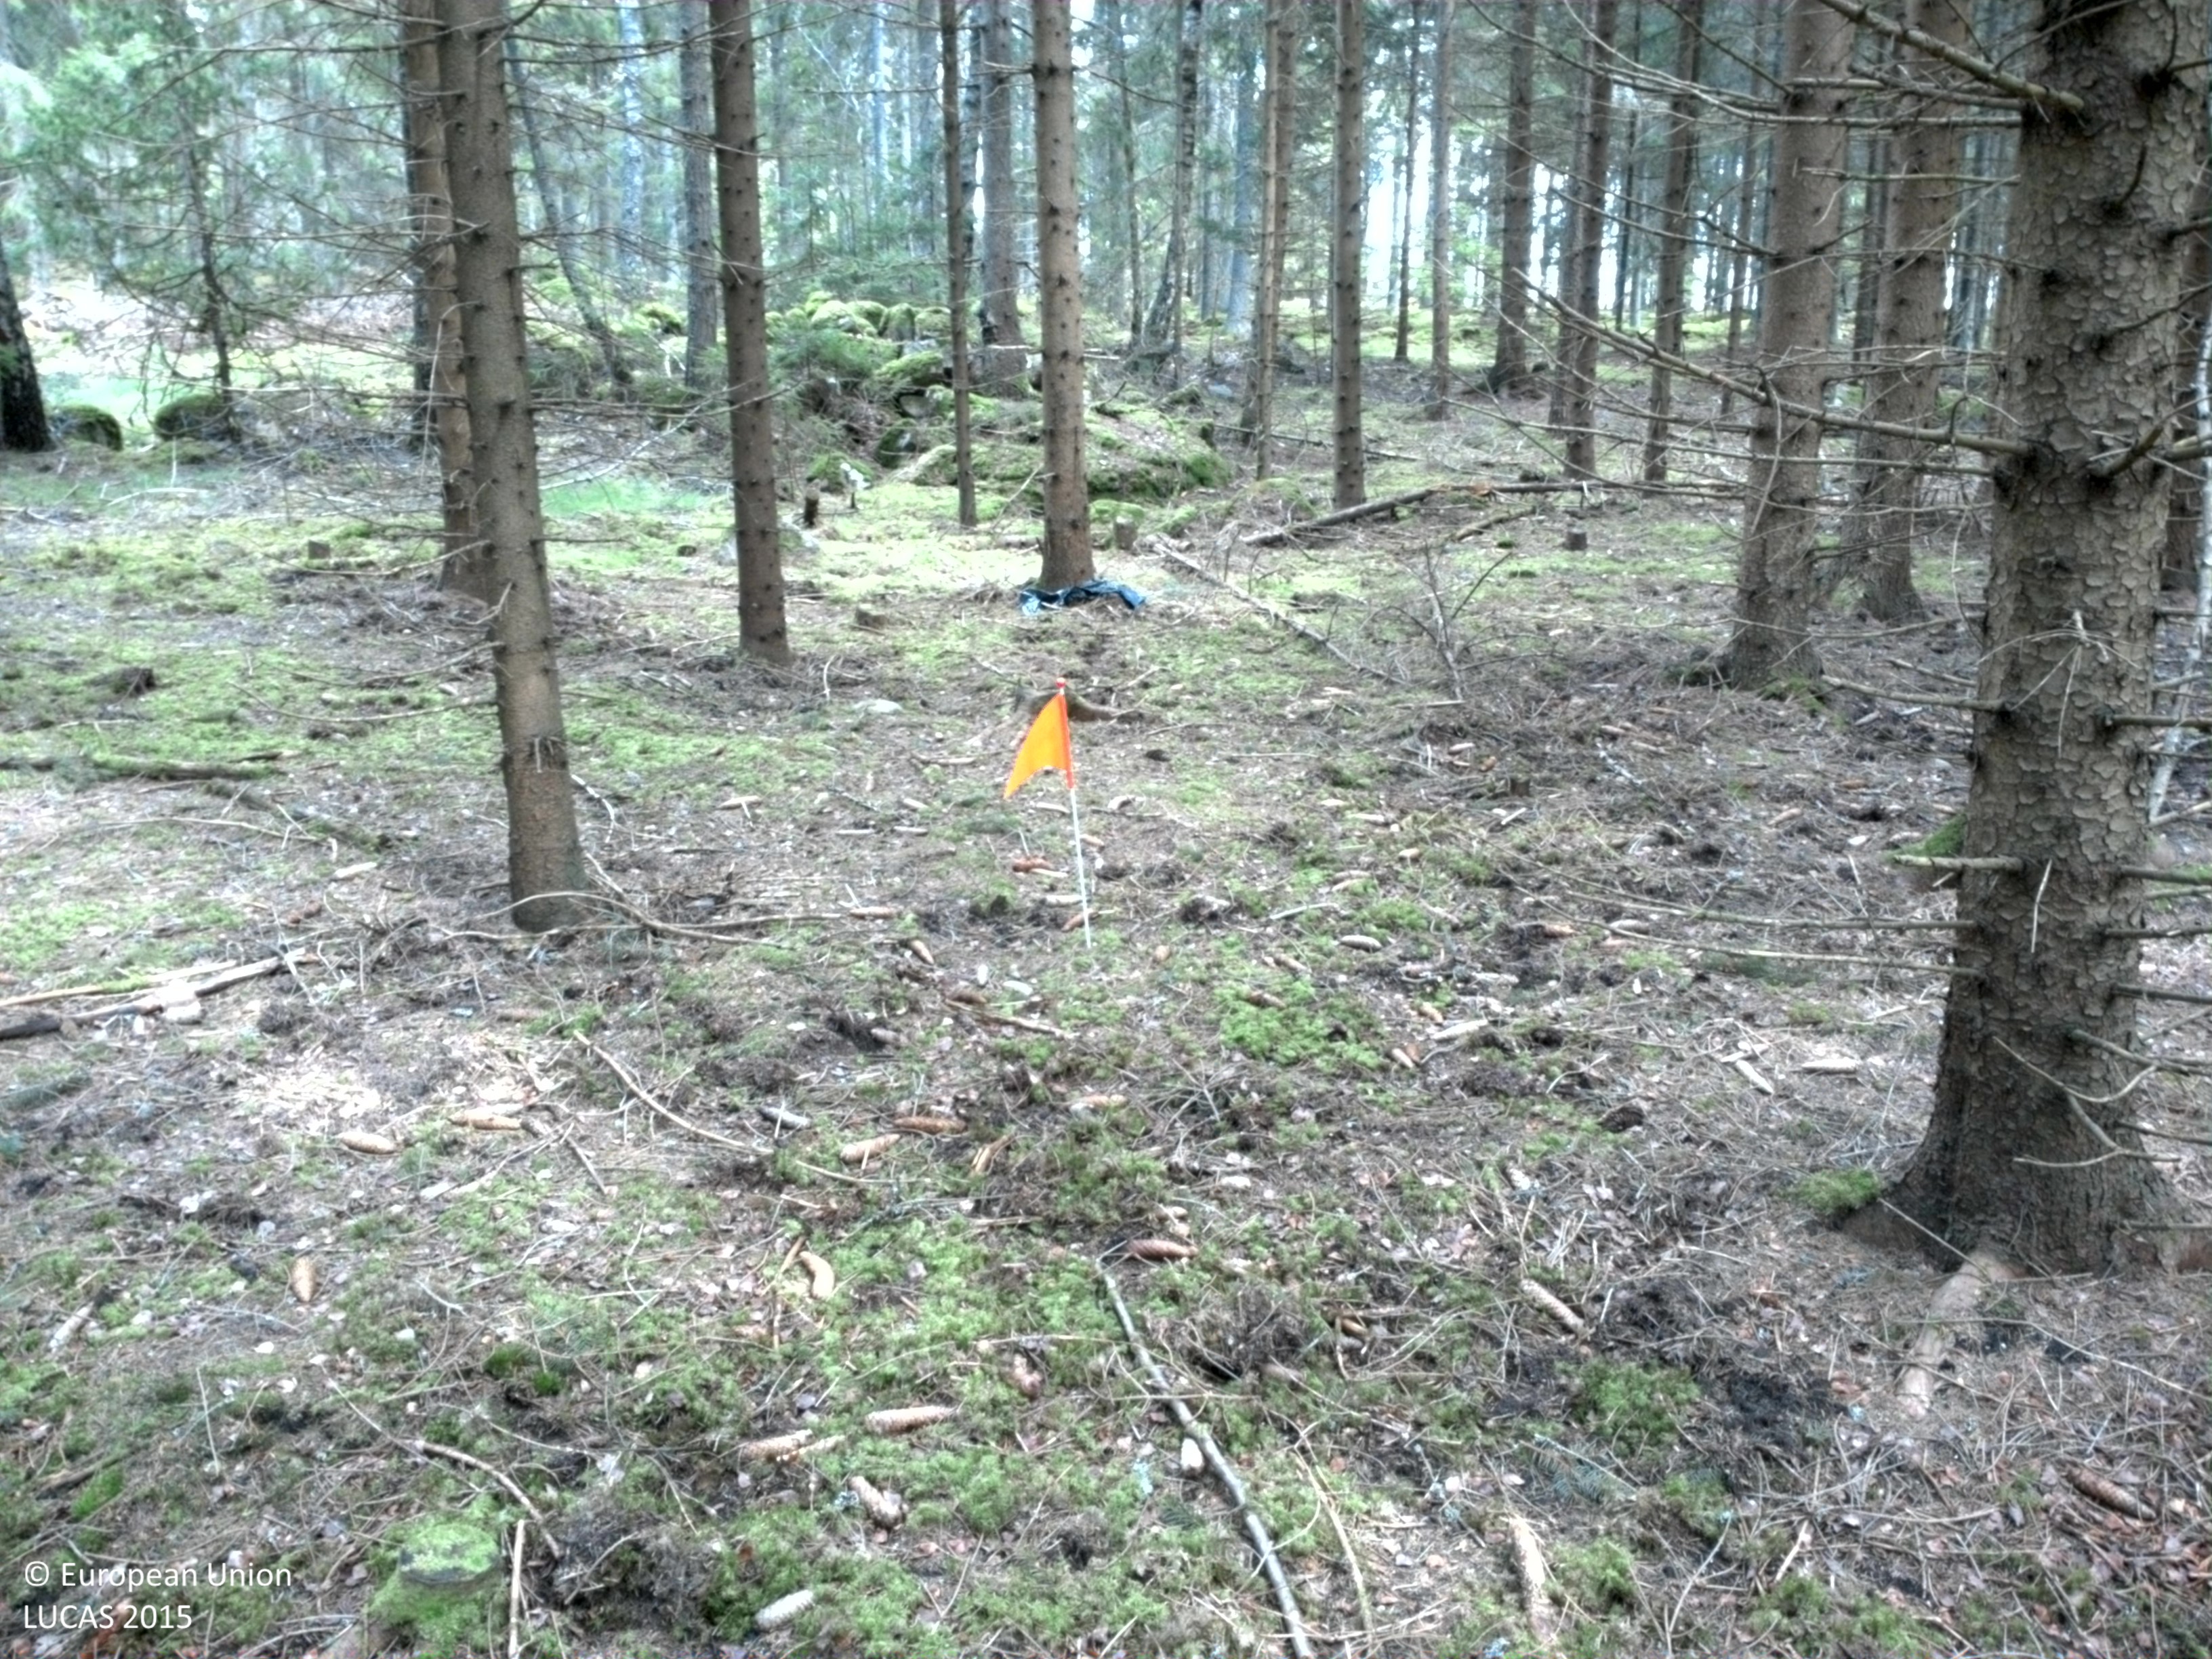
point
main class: Woodland
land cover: Spruce dominated coniferous woodland
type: boreal forest
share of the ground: > 75 %
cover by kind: coniferous forest trees 95 %, broadleaved forest trees 5 %
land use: Forestry
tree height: > 5 m
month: May
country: SE
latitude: 56.4884
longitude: 15.4069
